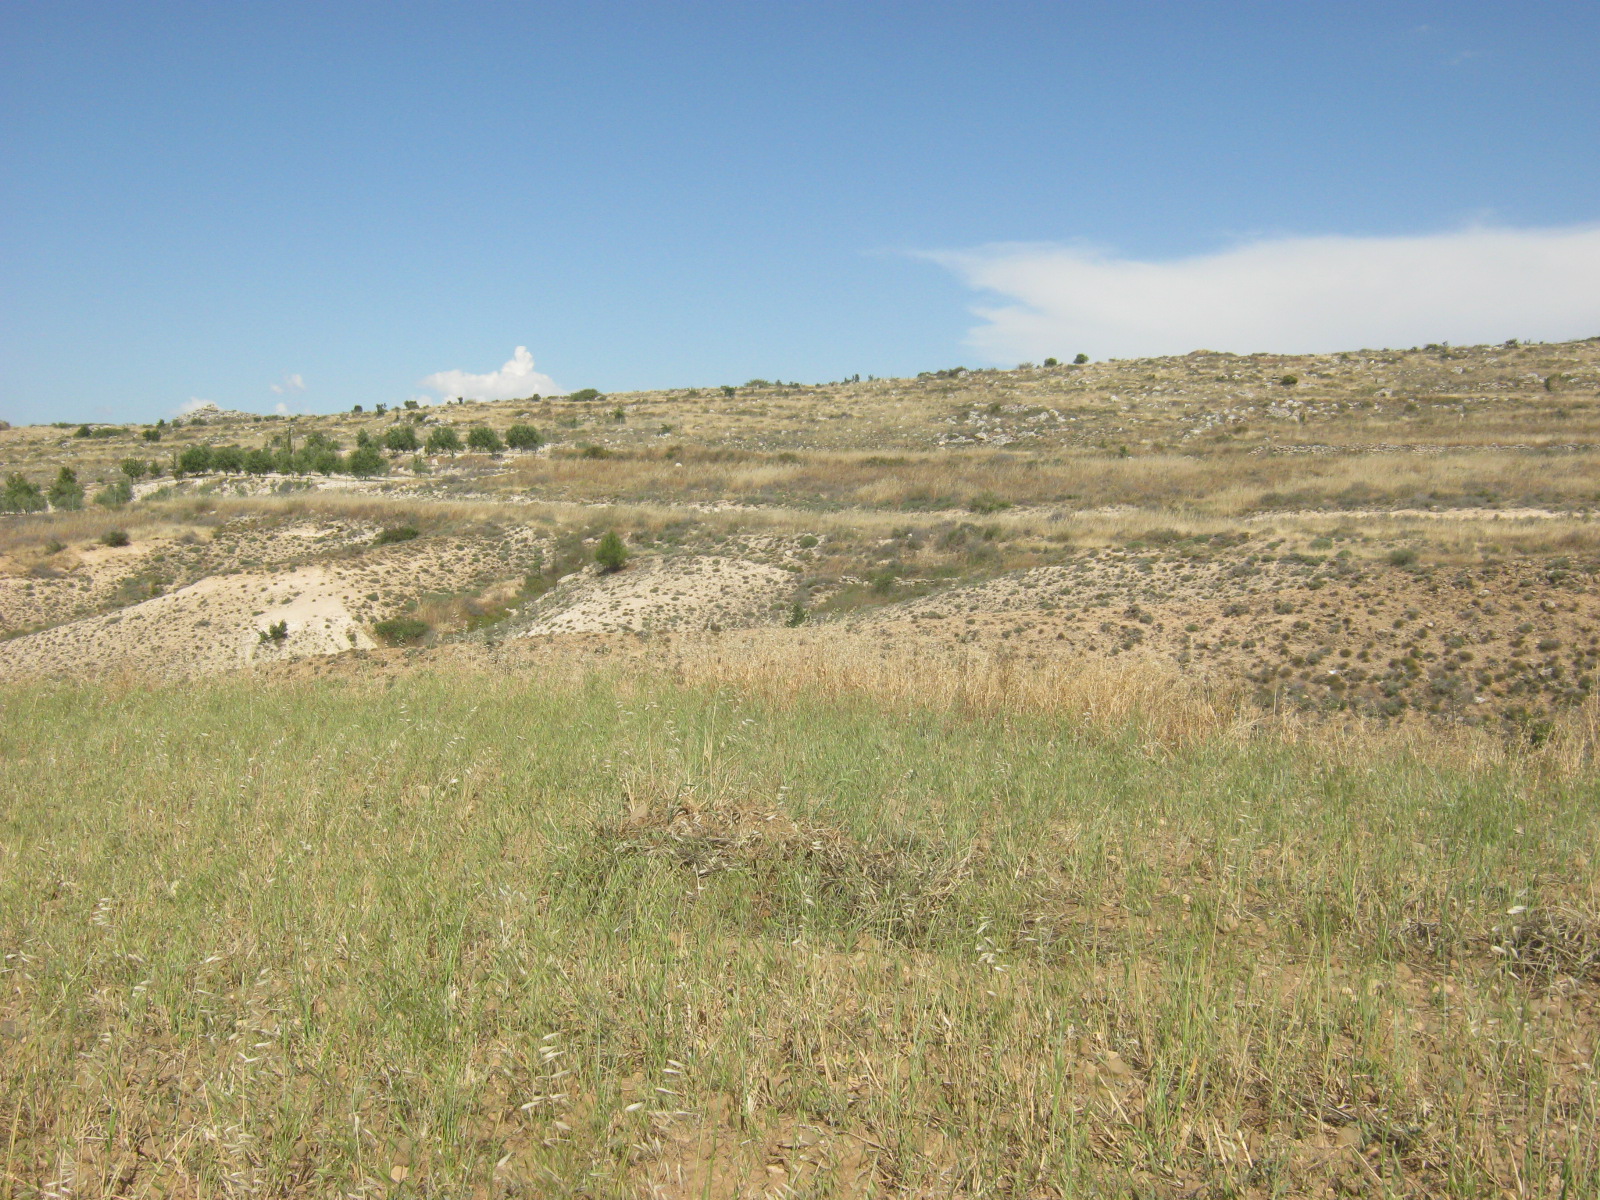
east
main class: Grassland
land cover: Spontaneously vegetated surfaces
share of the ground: > 75 %
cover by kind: herbaceous plants 80 %, unconsolidated bare surface 20 %
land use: Fallow land
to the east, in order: Spontaneously vegetated surfaces; Shrubland without tree cover; Rivers and streams; Shrubland without tree cover; Rivers and streams; Shrubland without tree cover; Dry stone walls; Shrubland without tree cover; Shrubland with sparse tree cover
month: May
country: CY
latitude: 35.0876
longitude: 33.0251
